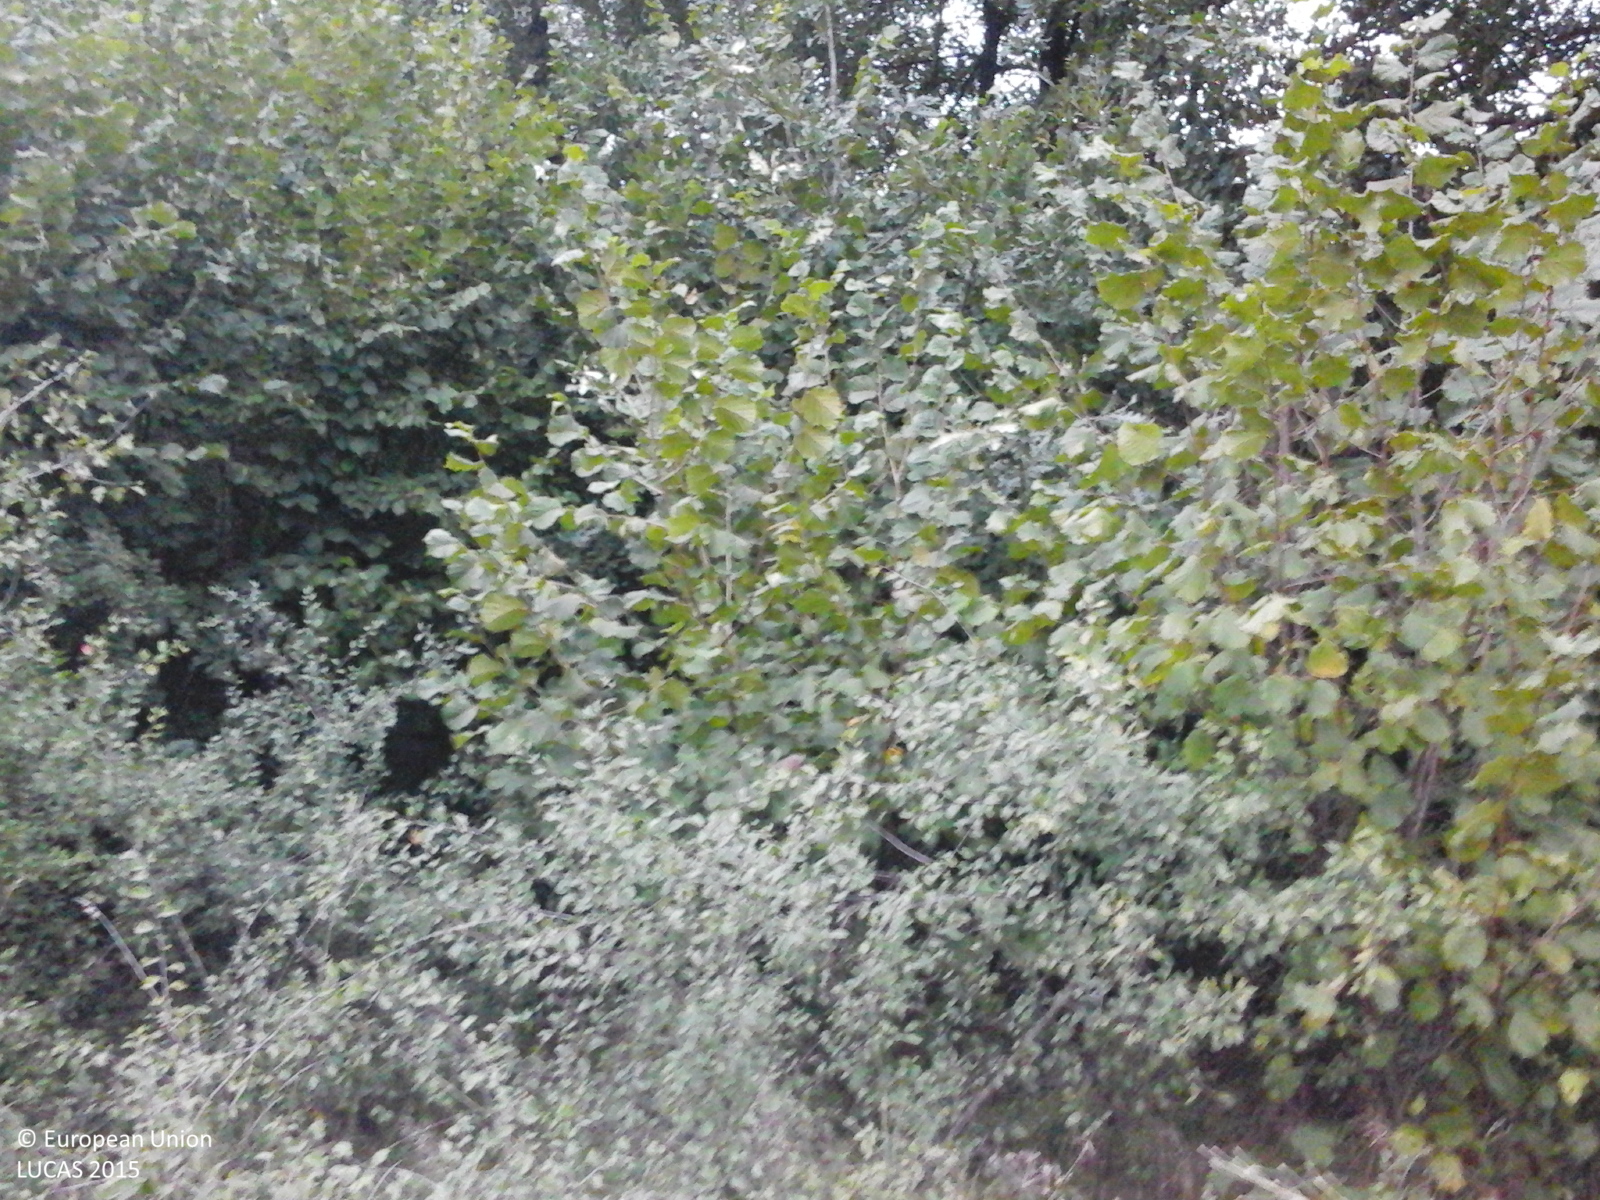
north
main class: Grassland
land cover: Grassland with sparse tree/shrub cover
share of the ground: > 75 %
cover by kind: herbaceous plants 90 %, broadleaved forest trees 5 %, shrubs 5 %
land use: Agriculture (excluding fallow land and kitchen gardens)
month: September
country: RO
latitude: 45.8868
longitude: 23.3992
